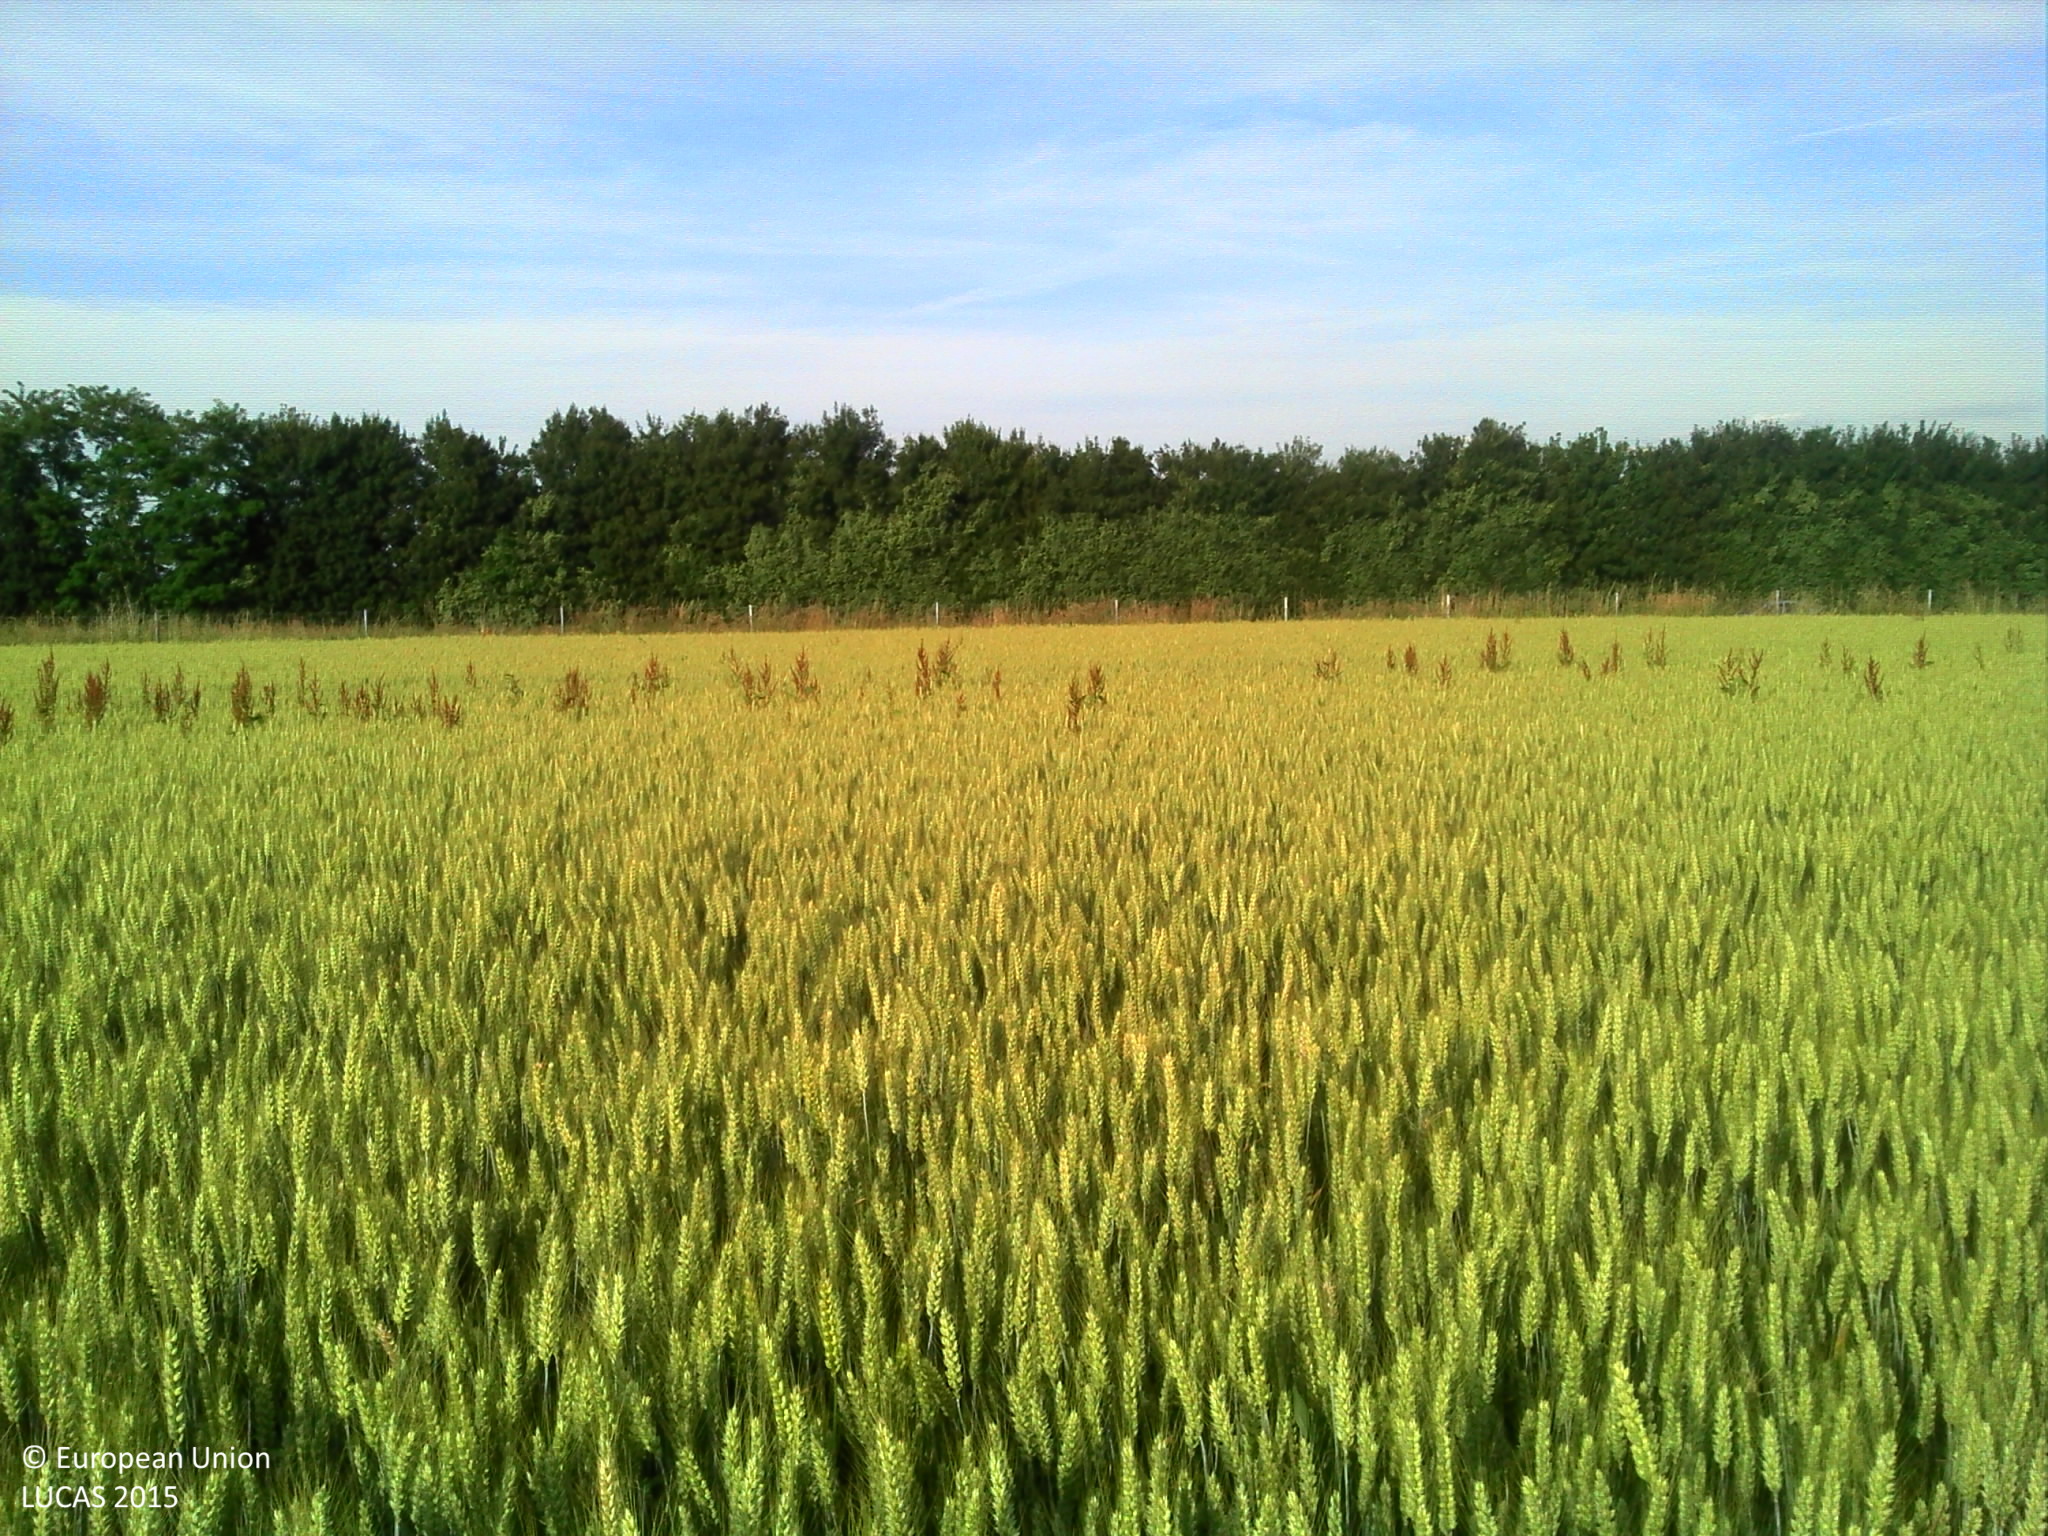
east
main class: Cropland
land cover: Common wheat
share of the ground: > 75 %
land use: Agriculture (excluding fallow land and kitchen gardens)
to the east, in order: Common wheat; Fences; Grassland without tree/shrub cover; Fences; Paved roads, cycling and walking lanes; Grass margins; Fences; Lines of trees; Other fibre and oleaginous crops
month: June
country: FR
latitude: 49.1773
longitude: 1.2418
